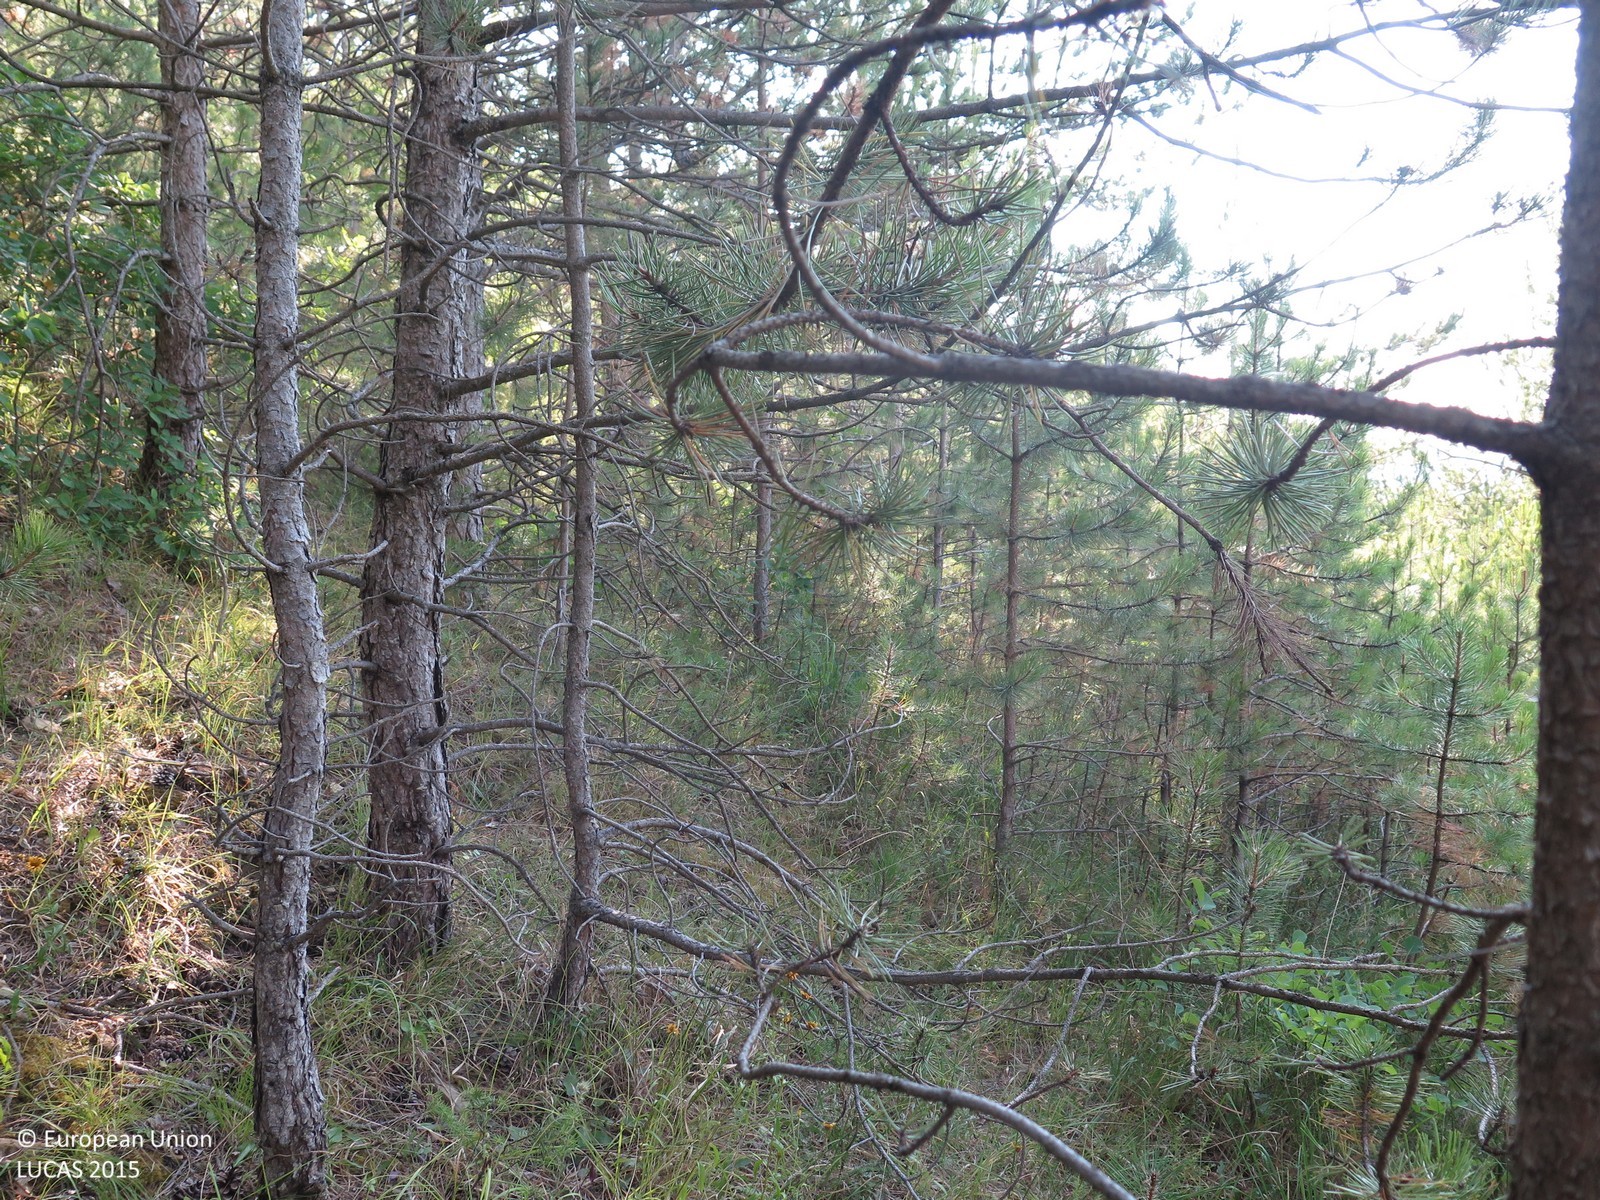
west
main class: Woodland
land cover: Pine dominated coniferous woodland
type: coniferous forest of the mediterranean region
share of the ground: > 75 %
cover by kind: coniferous forest trees 90 %, shrubs 5 %, herbaceous plants 5 %
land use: Semi-natural and natural areas not in use
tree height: > 5 m
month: July
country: HR
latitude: 45.3606
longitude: 13.8887
